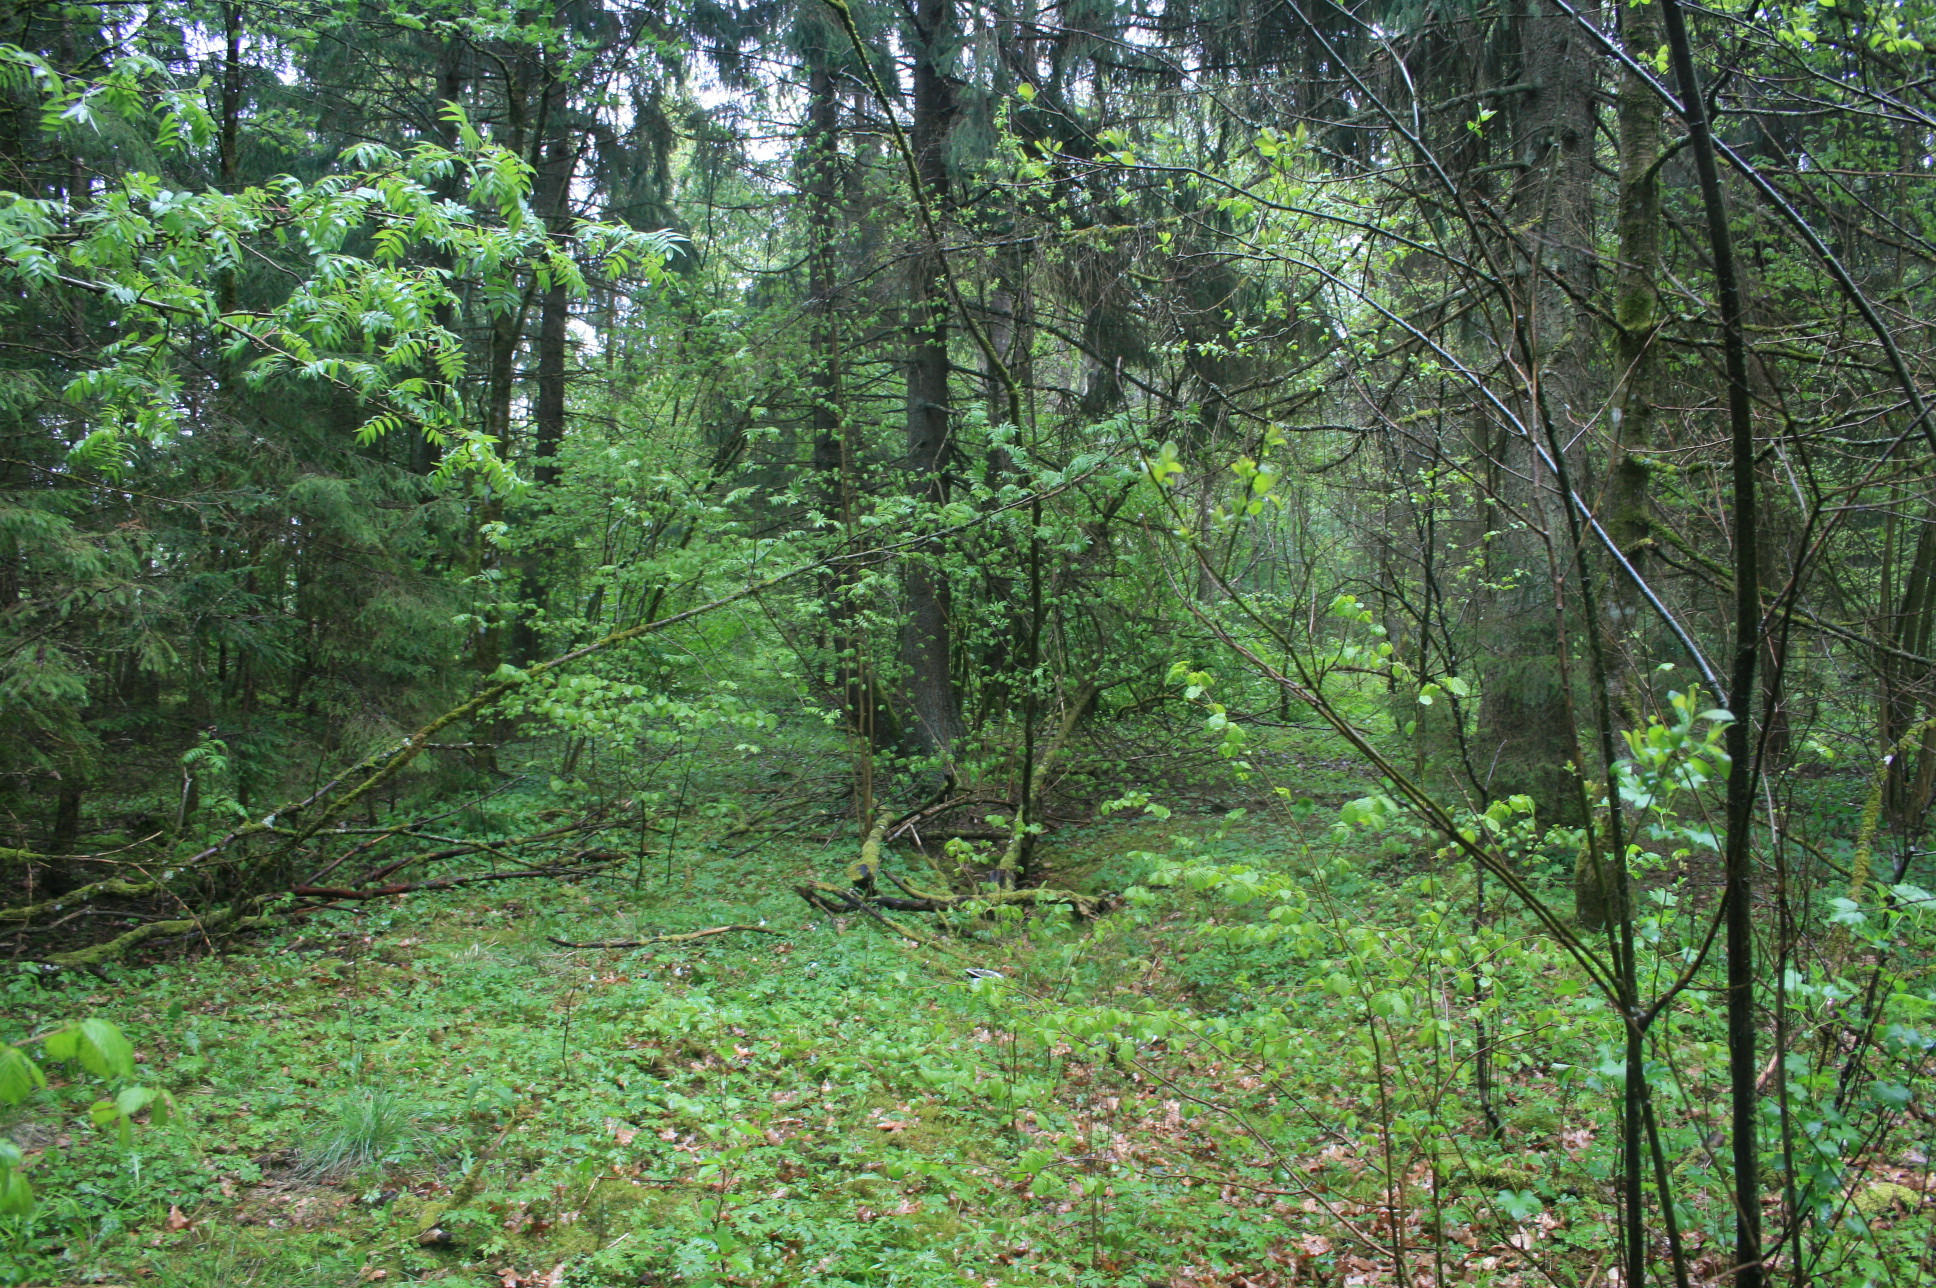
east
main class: Woodland
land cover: Spruce dominated mixed woodland
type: hemiboreal forest and nemoral coniferous forest and mixed broadleaved-coniferous forest
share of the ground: > 75 %
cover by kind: coniferous forest trees 70 %, broadleaved forest trees 25 %, lichens and mosses 5 %
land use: Forestry
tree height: > 5 m
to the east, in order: Spruce dominated mixed woodland; Barley
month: May
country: LT
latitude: 56.2080
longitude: 21.9638
